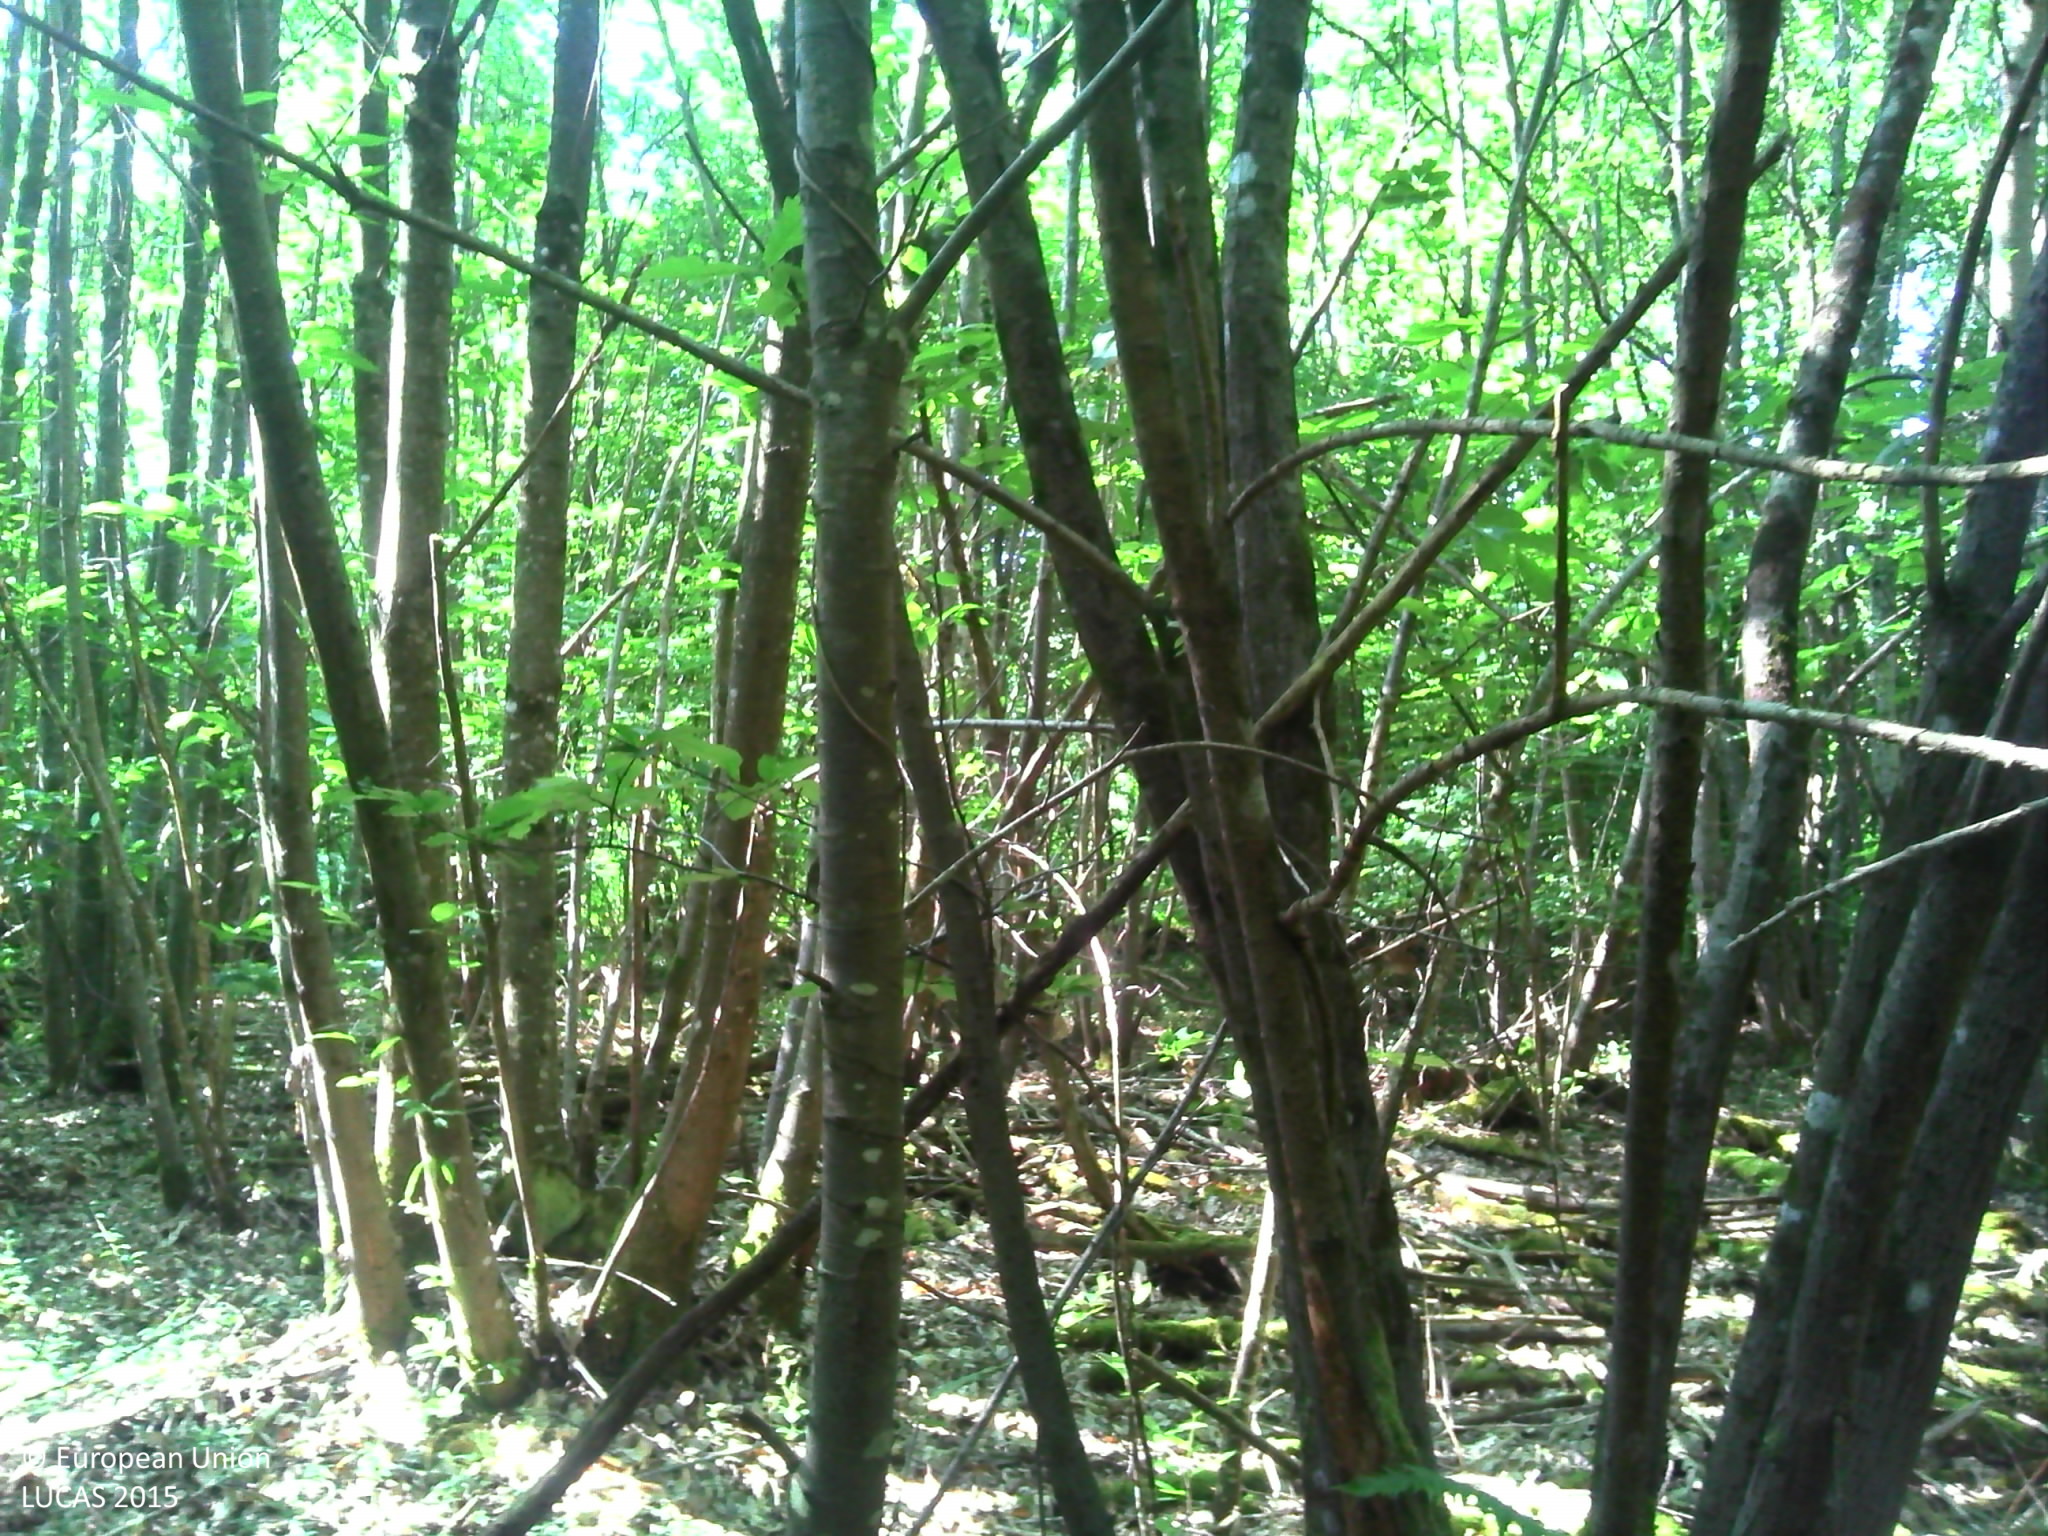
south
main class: Woodland
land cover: Broadleaved woodland
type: beech forest
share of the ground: > 75 %
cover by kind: broadleaved forest trees 70 %, herbaceous plants 20 %, lichens and mosses 10 %
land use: Forestry
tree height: > 5 m
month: June
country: FR
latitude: 47.7707
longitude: 0.0322
